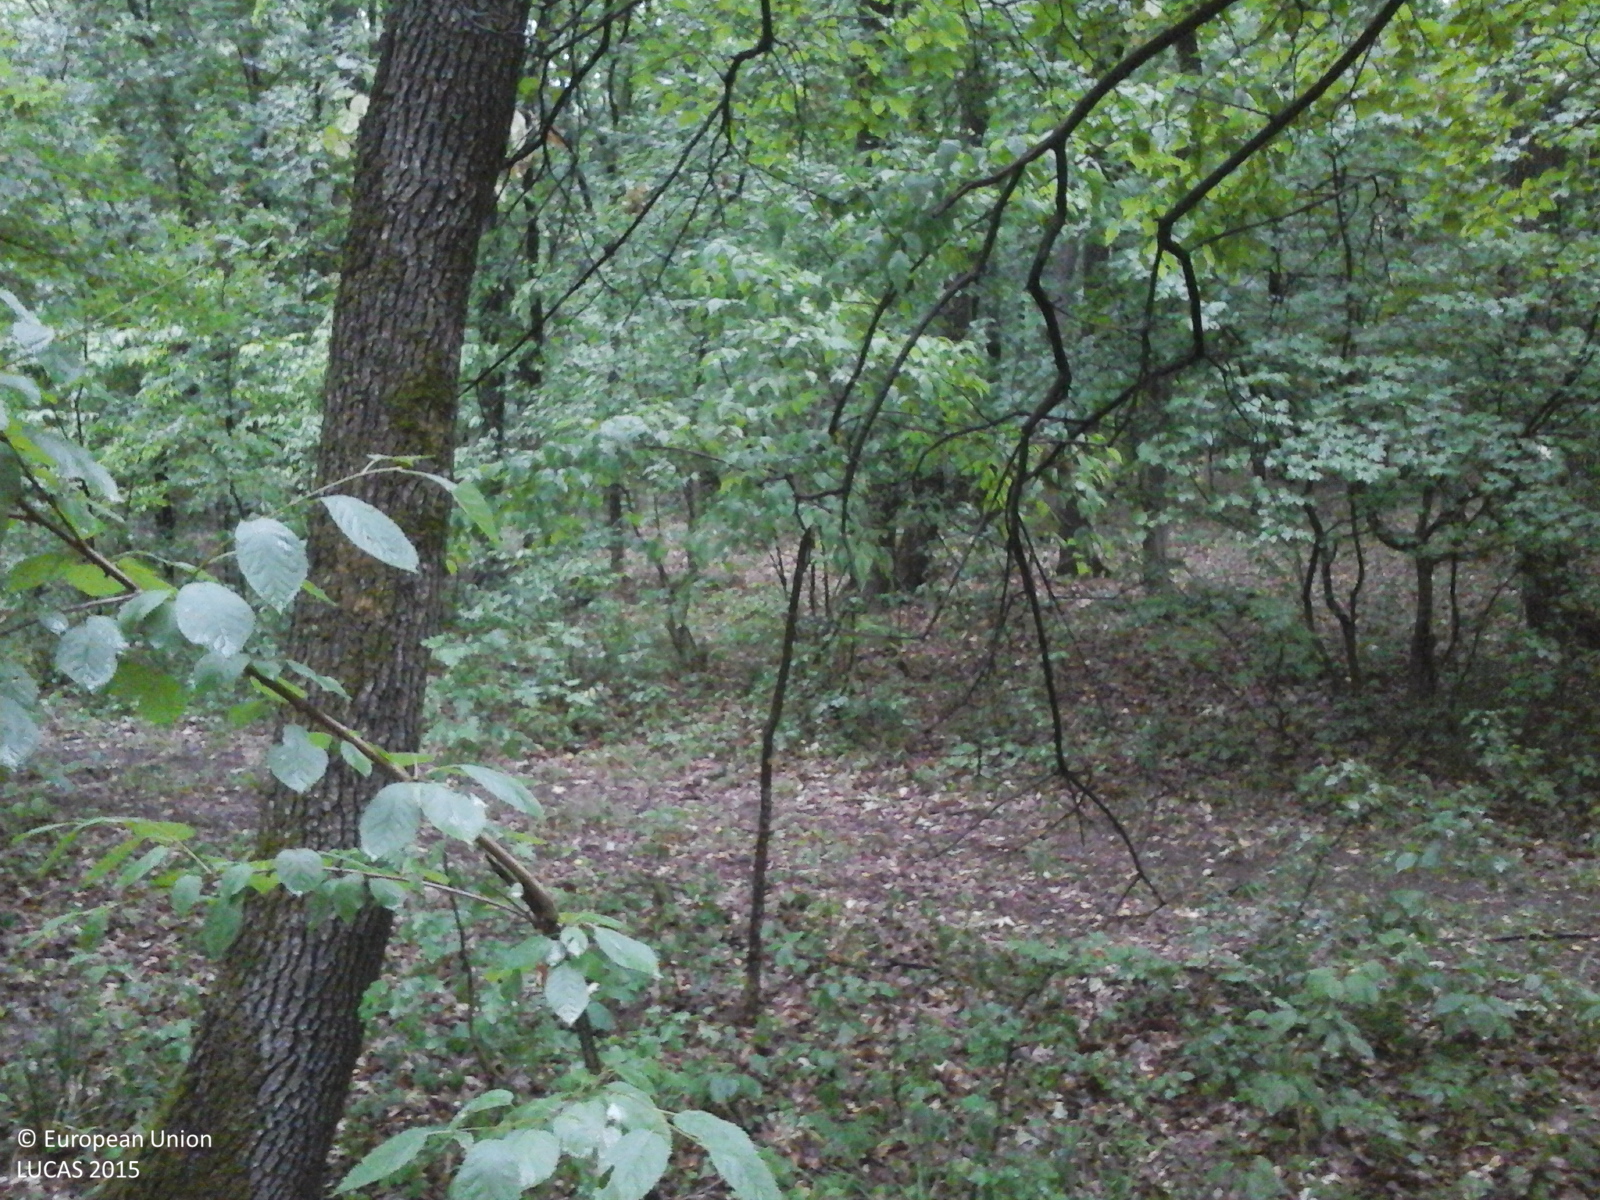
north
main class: Woodland
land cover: Broadleaved woodland
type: beech forest
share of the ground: > 75 %
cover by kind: broadleaved forest trees 95 %, herbaceous plants 5 %
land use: Forestry
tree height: > 5 m
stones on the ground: < 10 %
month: June
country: RO
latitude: 47.7616
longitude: 26.9538
